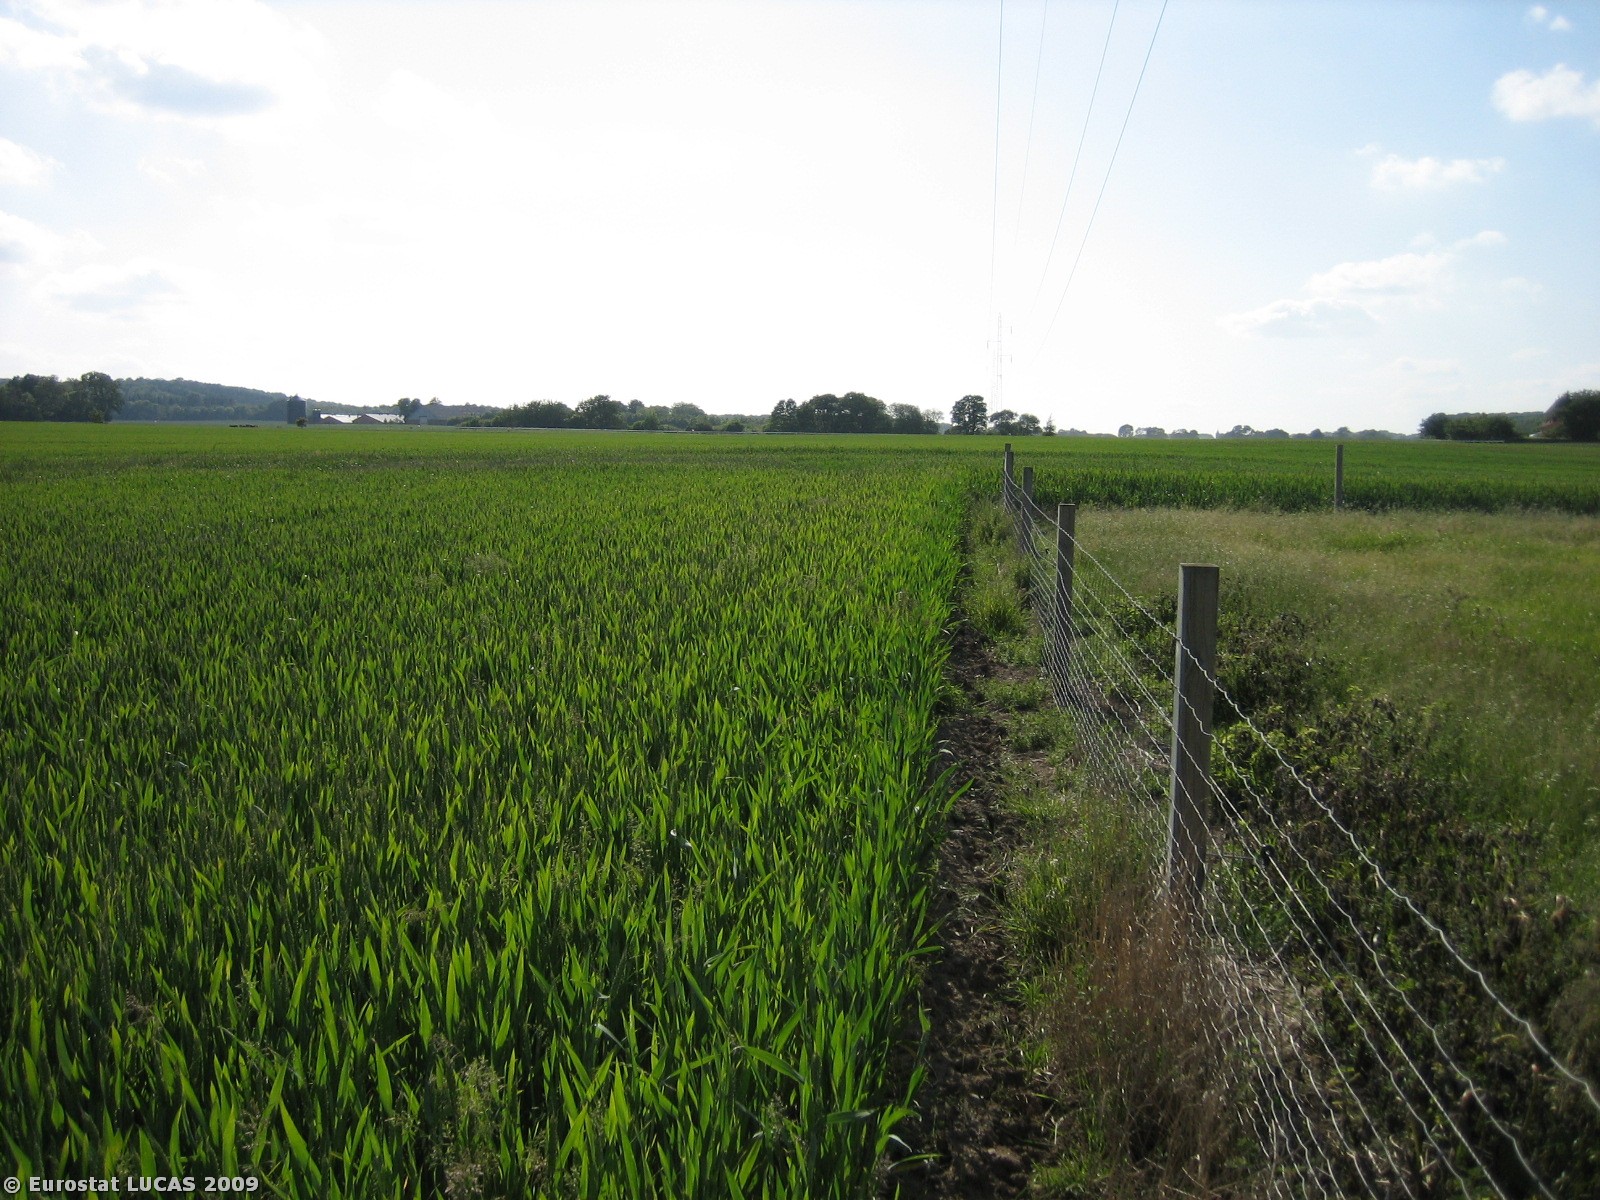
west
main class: Cropland
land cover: Common wheat
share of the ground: > 75 %
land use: Agriculture (excluding fallow land and kitchen gardens)
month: June
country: DK
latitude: 55.8102
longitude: 9.9203
